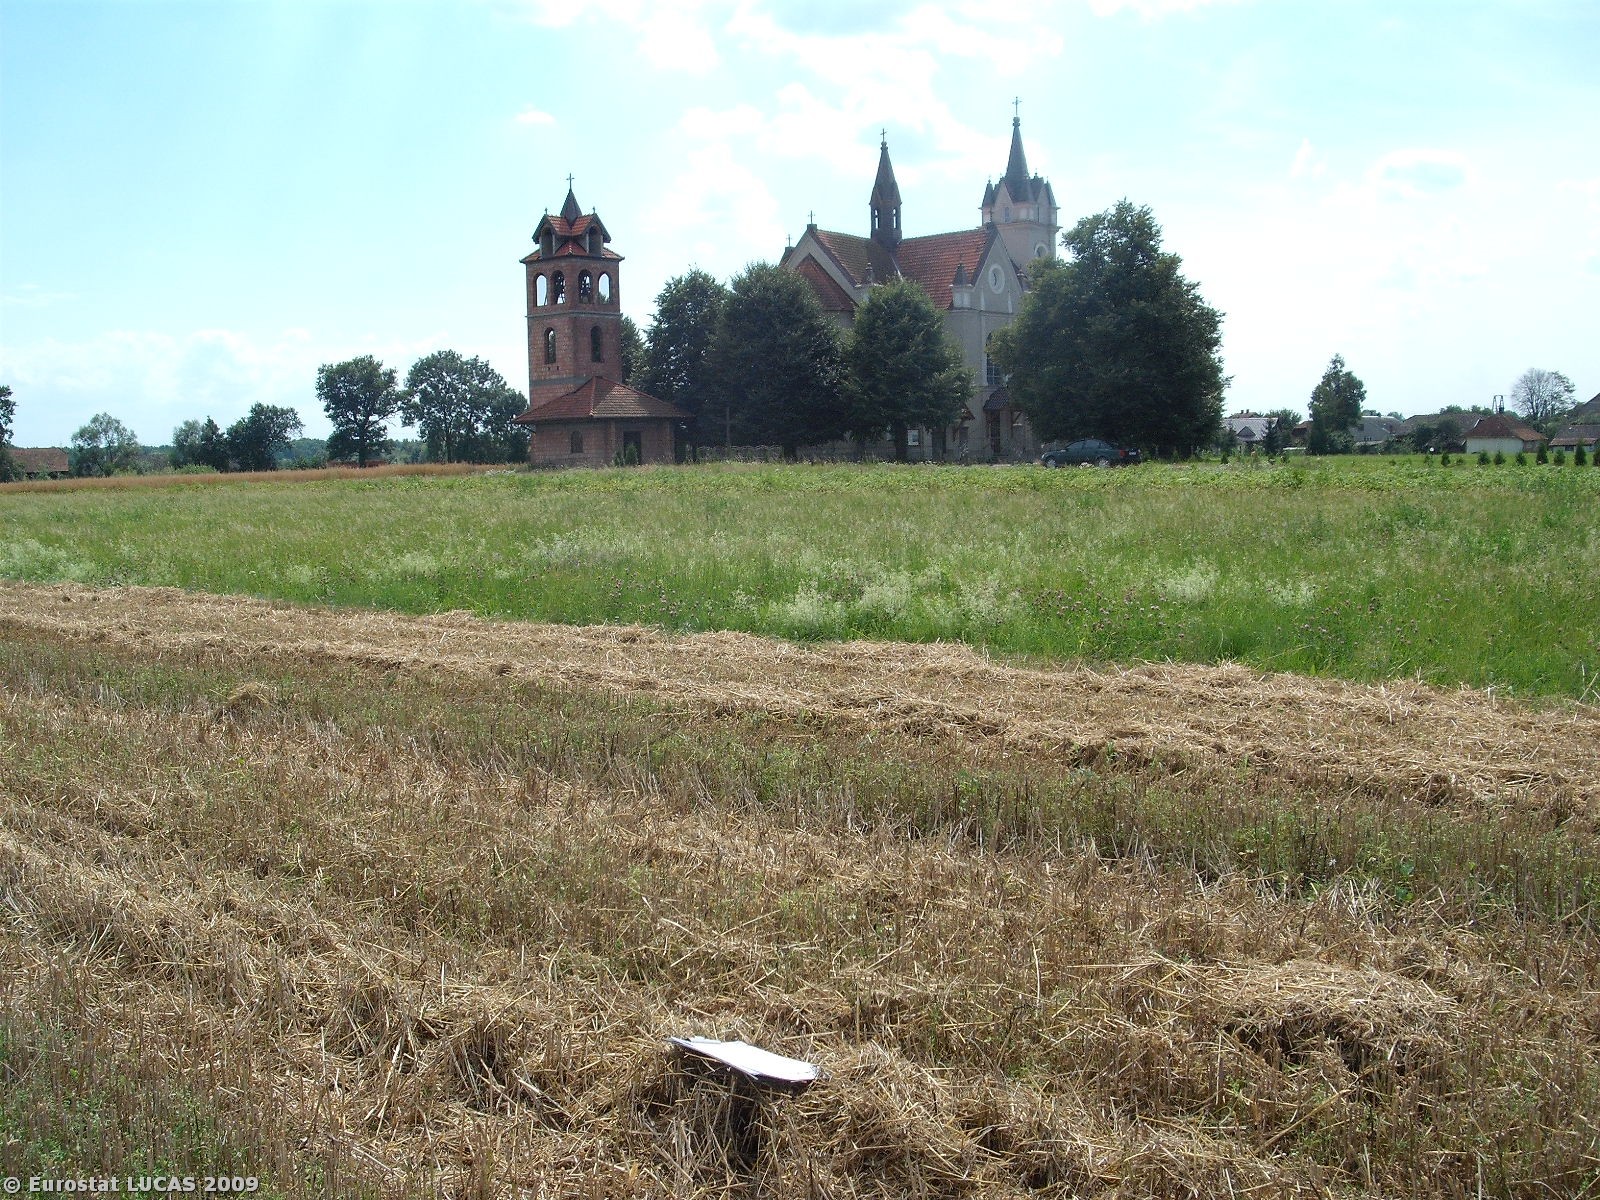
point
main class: Cropland
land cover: Rye
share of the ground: < 10 %
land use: Agriculture (excluding fallow land and kitchen gardens)
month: July
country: PL
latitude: 50.0582
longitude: 20.3302
